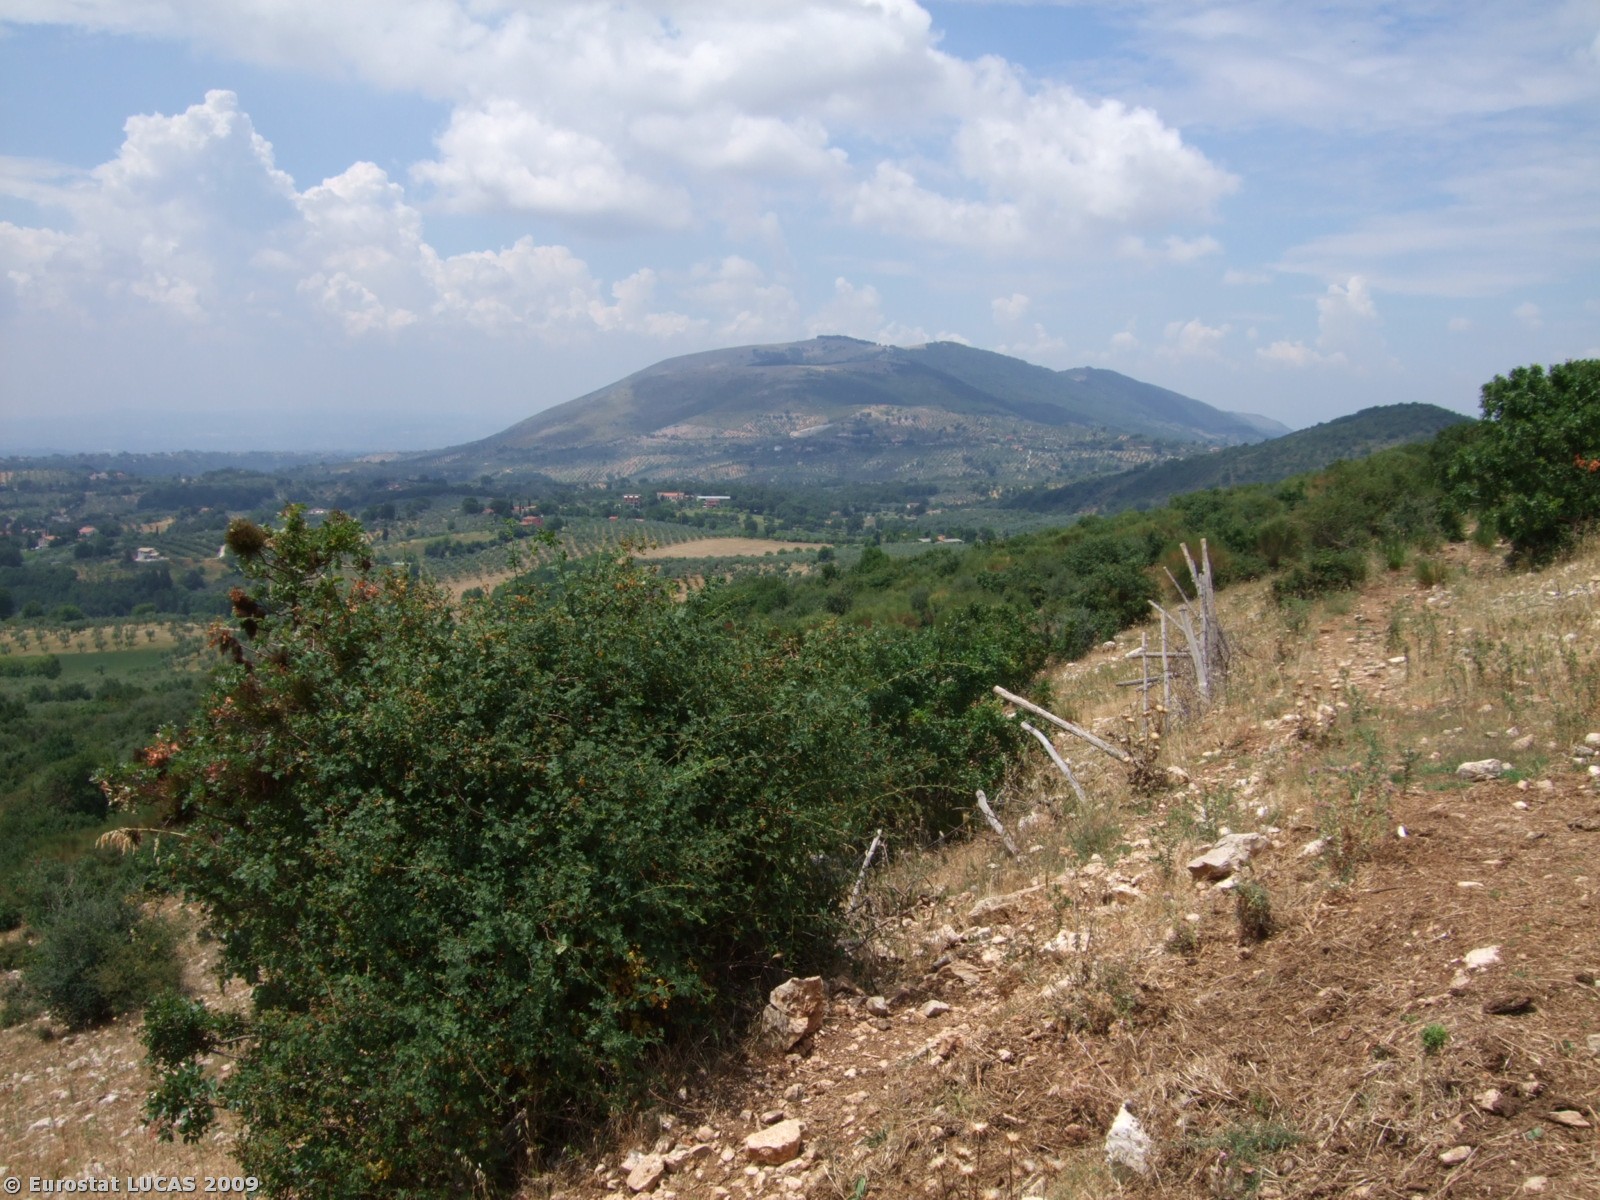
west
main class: Shrubland
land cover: Shrubland without tree cover
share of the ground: > 75 %
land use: Unused
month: June
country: IT
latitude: 42.1806
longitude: 12.8353
